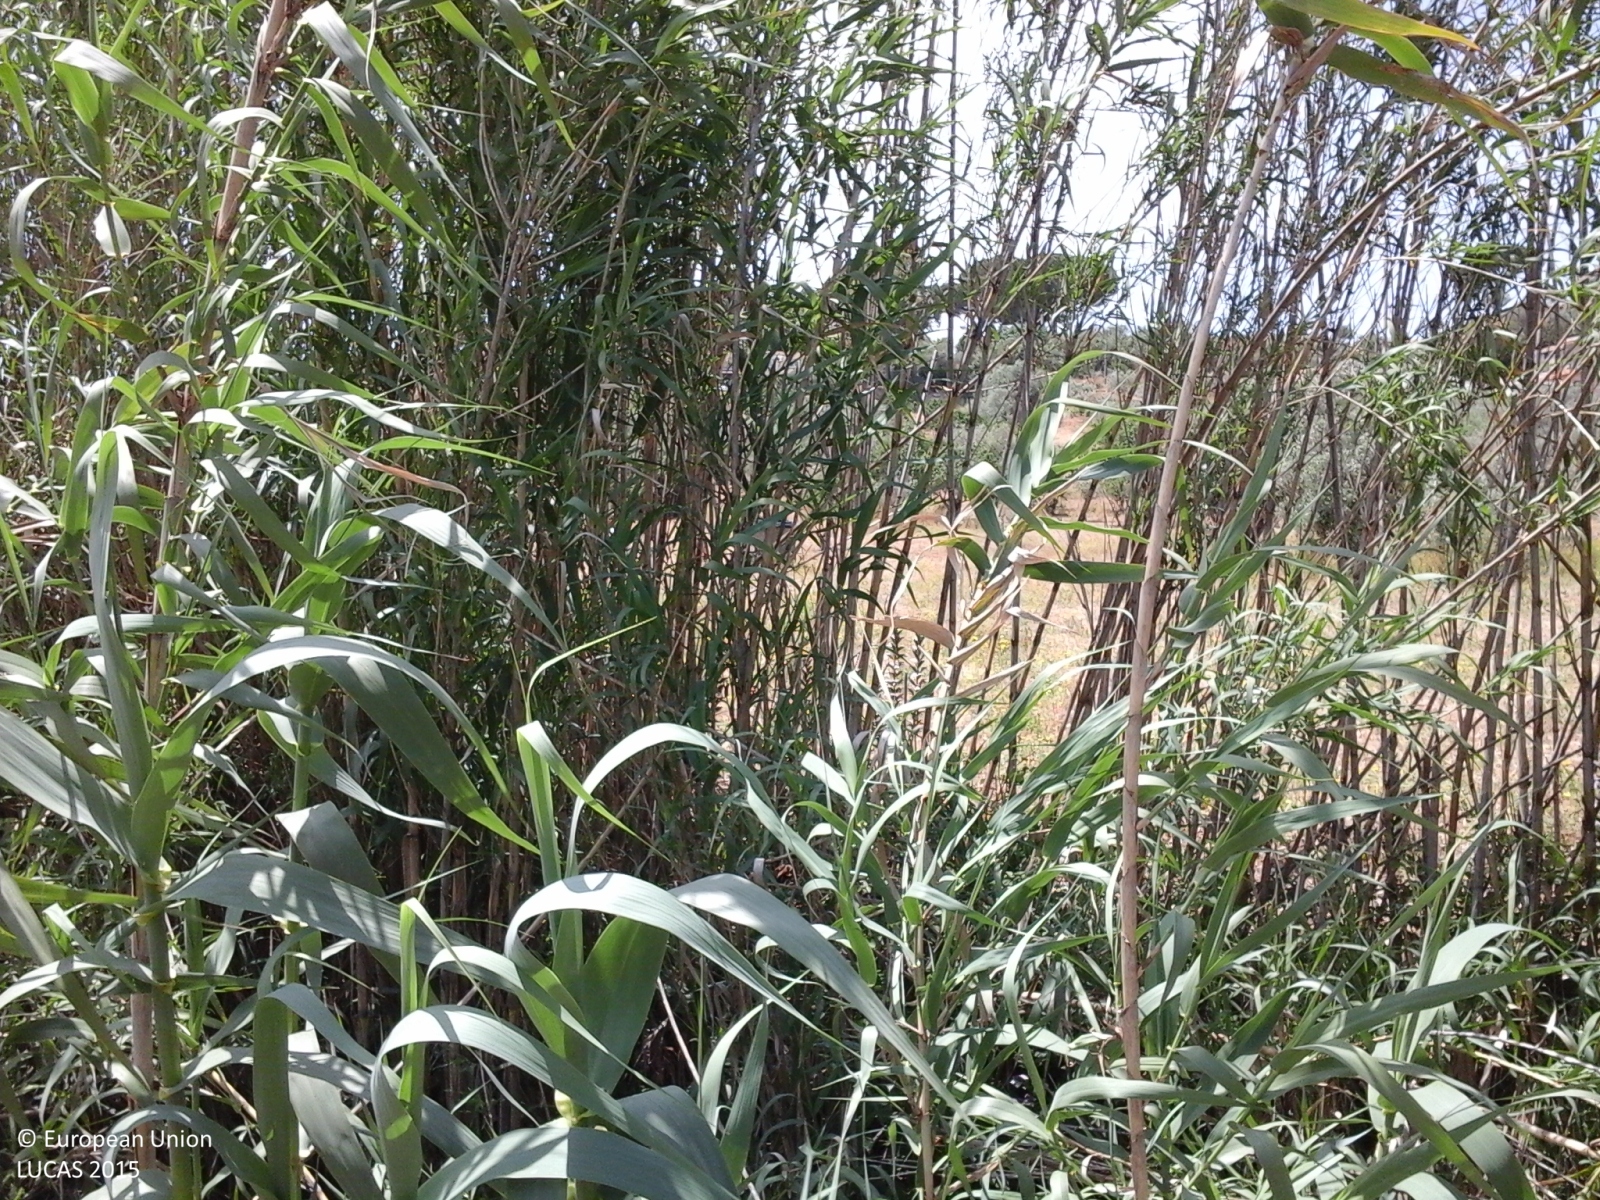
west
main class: Grassland
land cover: Spontaneously vegetated surfaces
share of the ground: 25 - 50 %
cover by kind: herbaceous plants 100 %
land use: Fallow land
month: May
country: IT
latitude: 37.3205
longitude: 14.3566
